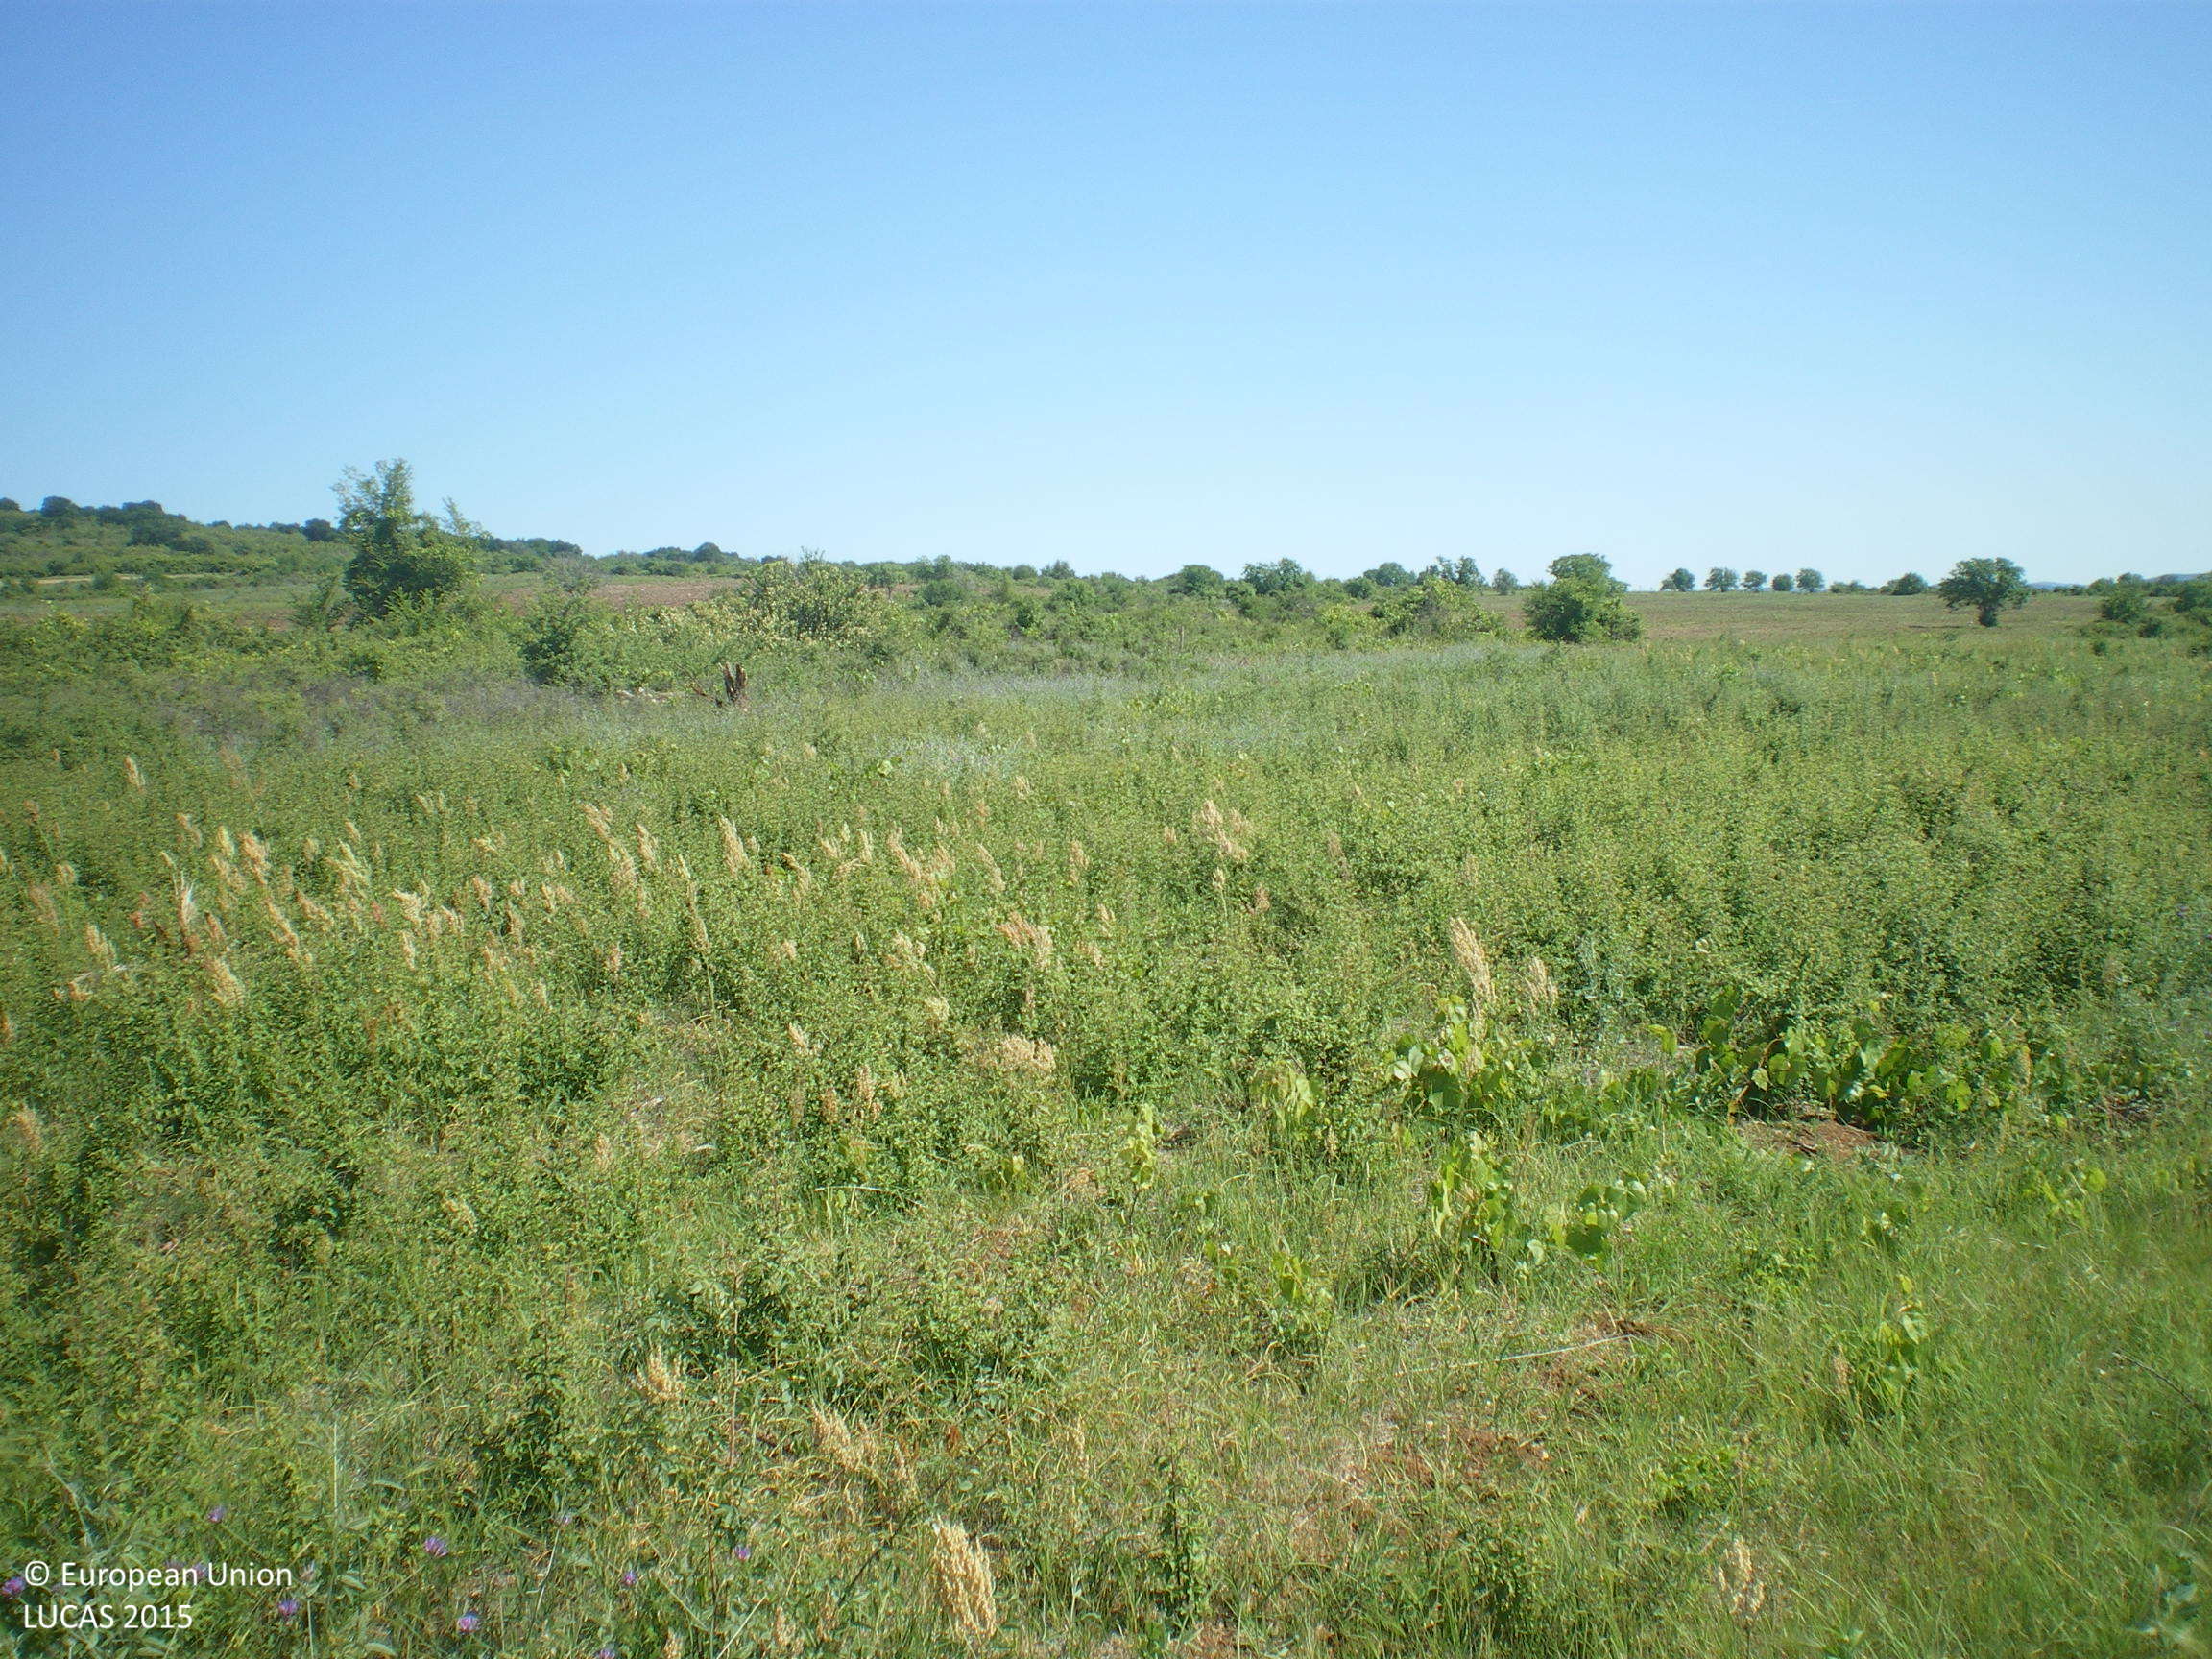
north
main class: Cropland
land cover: Vineyards
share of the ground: 10 - 25 %
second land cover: Shrubland without tree cover
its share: 50 - 75 %
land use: Abandoned areas
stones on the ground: < 10 %
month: June
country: BG
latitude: 42.3029
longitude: 25.4605
